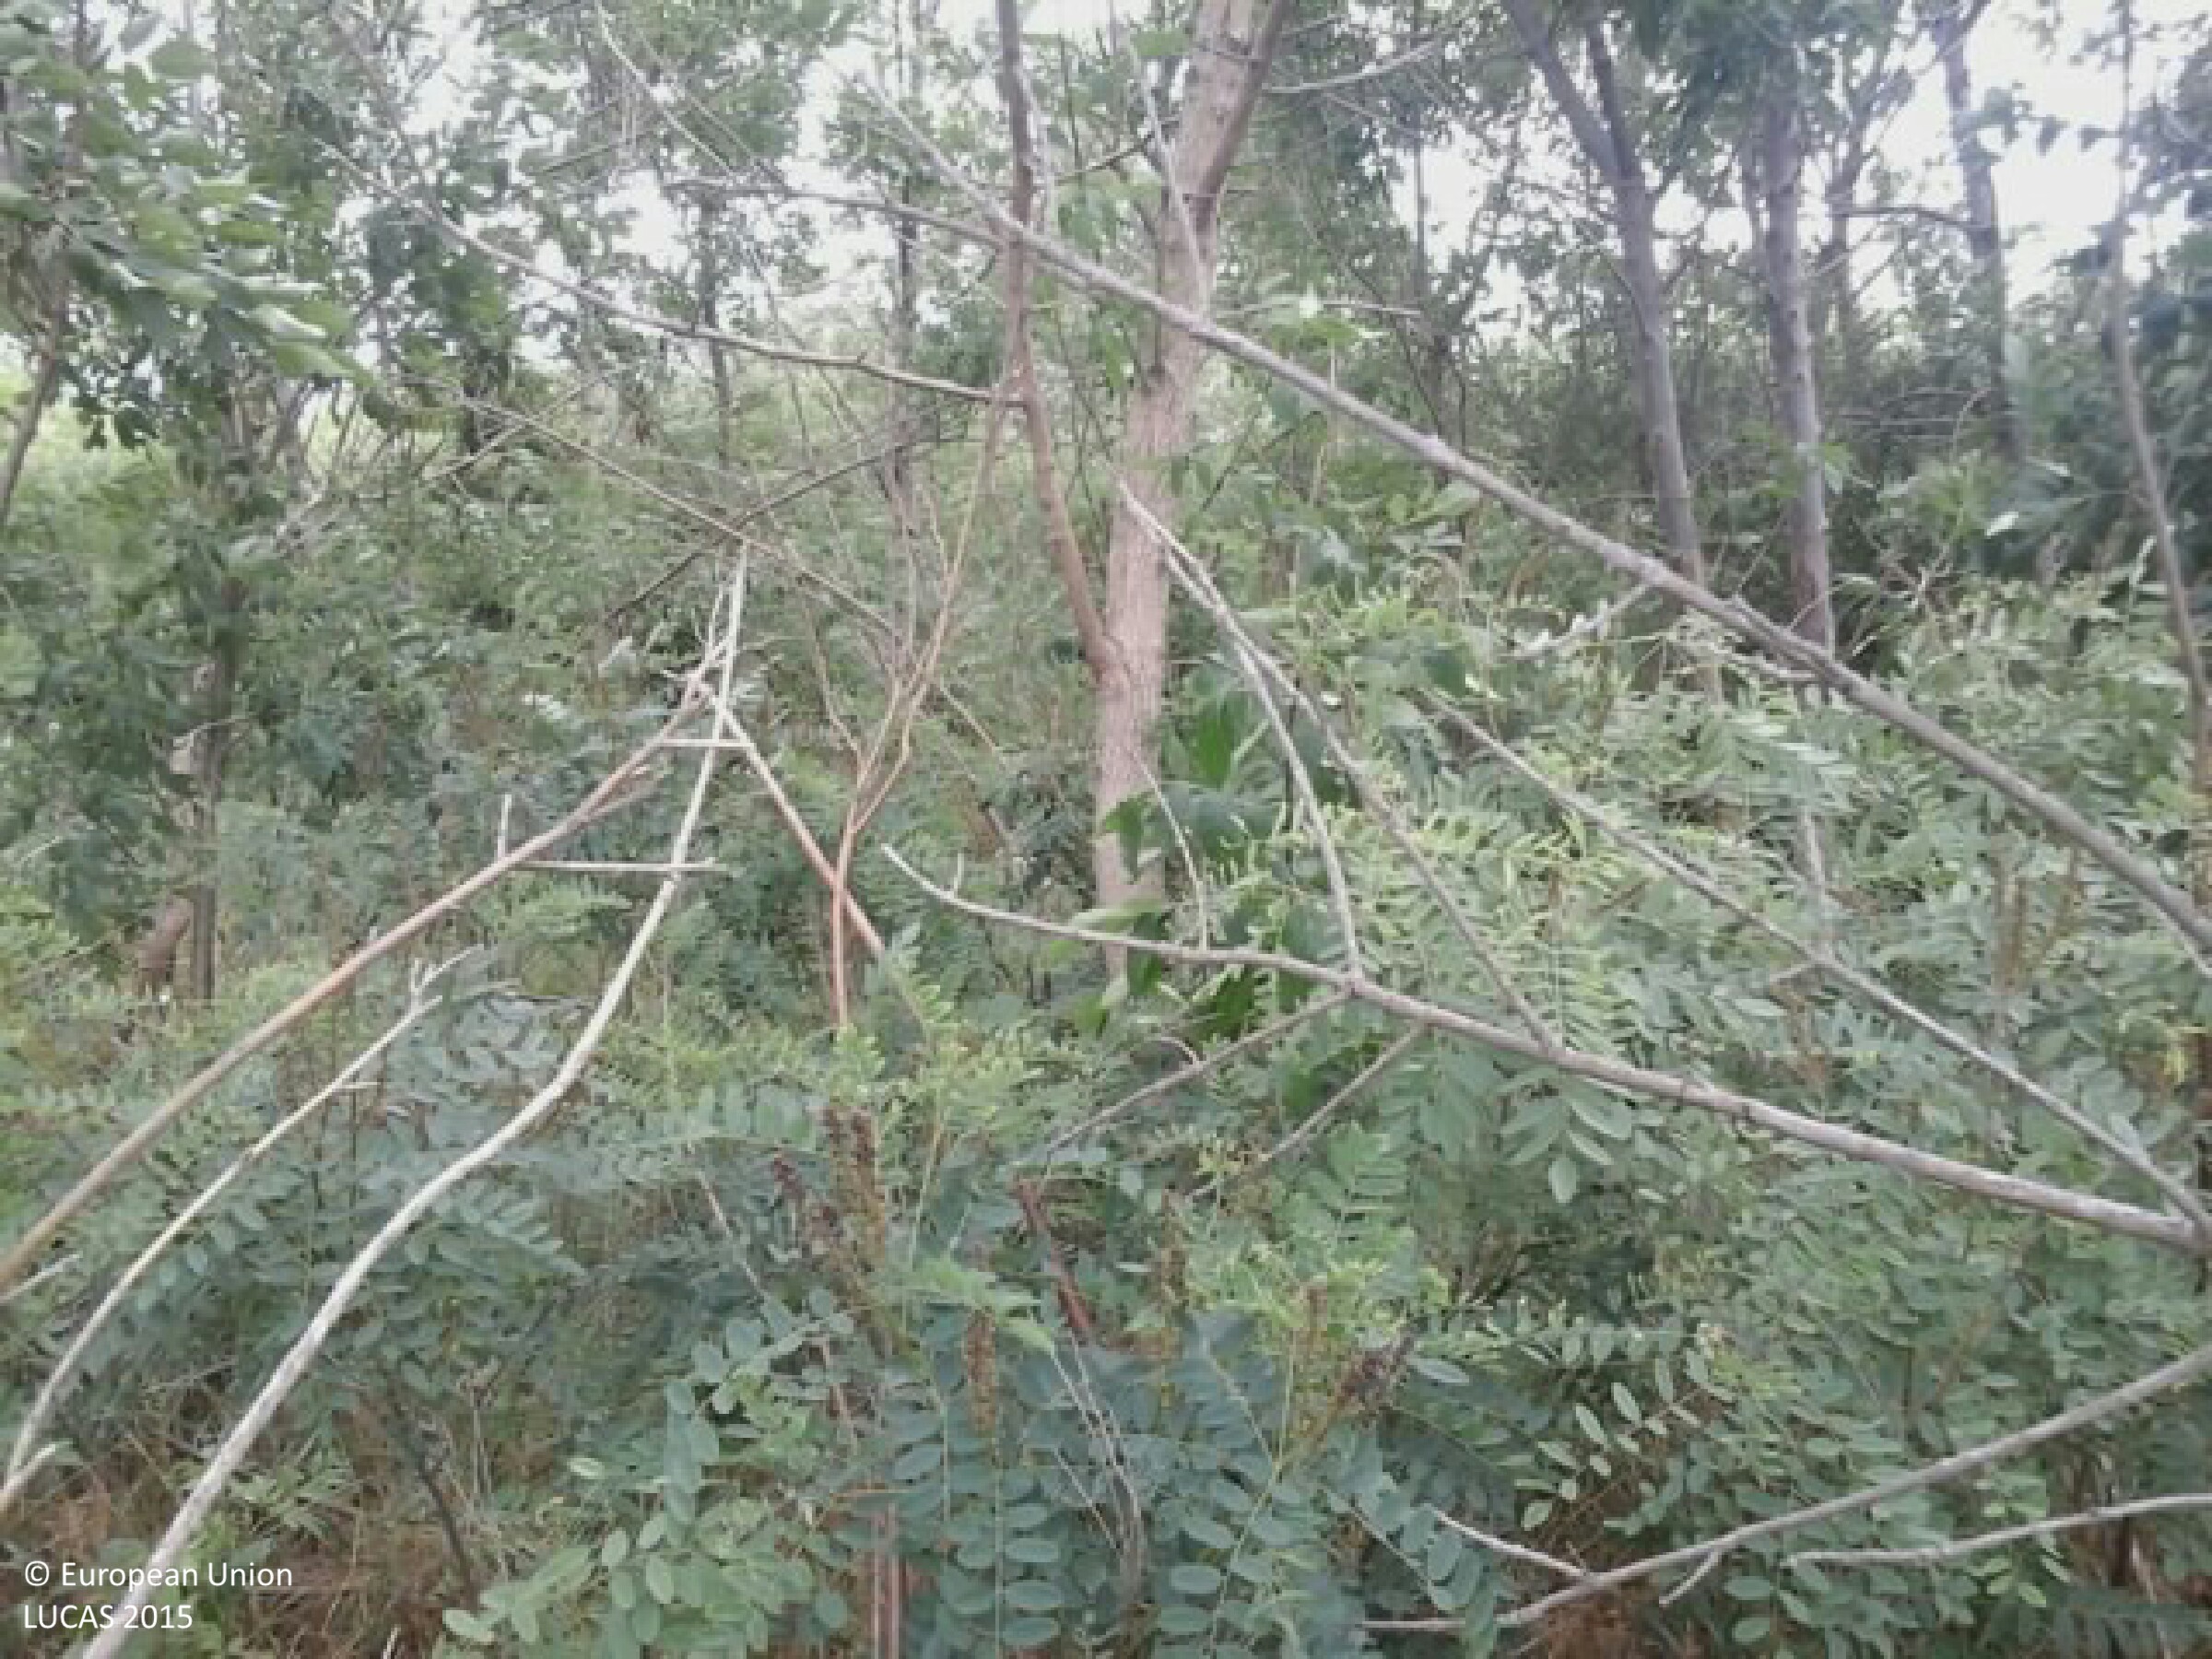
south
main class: Woodland
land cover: Broadleaved woodland
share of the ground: > 75 %
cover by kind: broadleaved forest trees 80 %, shrubs 20 %
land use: Semi-natural and natural areas not in use
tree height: > 5 m
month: June
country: HU
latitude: 46.5054
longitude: 20.3065
